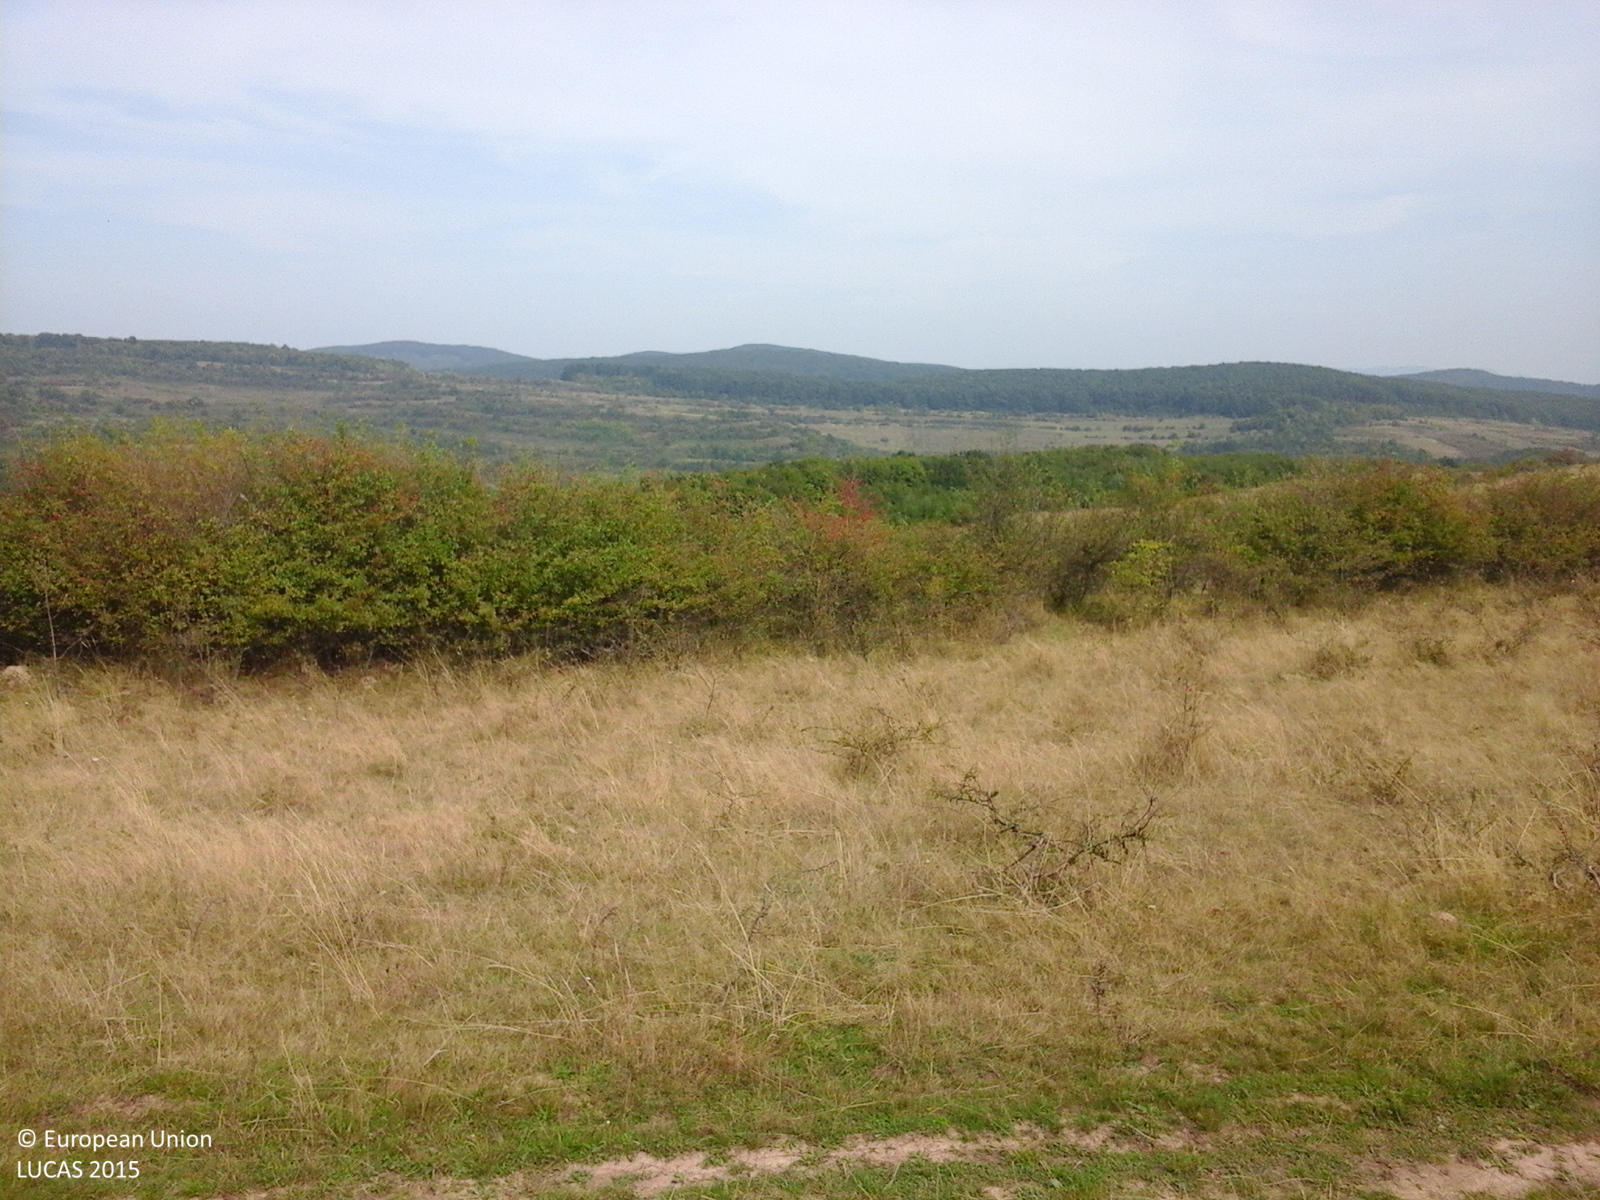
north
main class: Grassland
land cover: Grassland with sparse tree/shrub cover
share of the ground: > 75 %
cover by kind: herbaceous plants 85 %, shrubs 10 %, broadleaved forest trees 5 %
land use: Fallow land
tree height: < 5 m
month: September
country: RO
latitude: 47.1589
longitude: 23.7278
